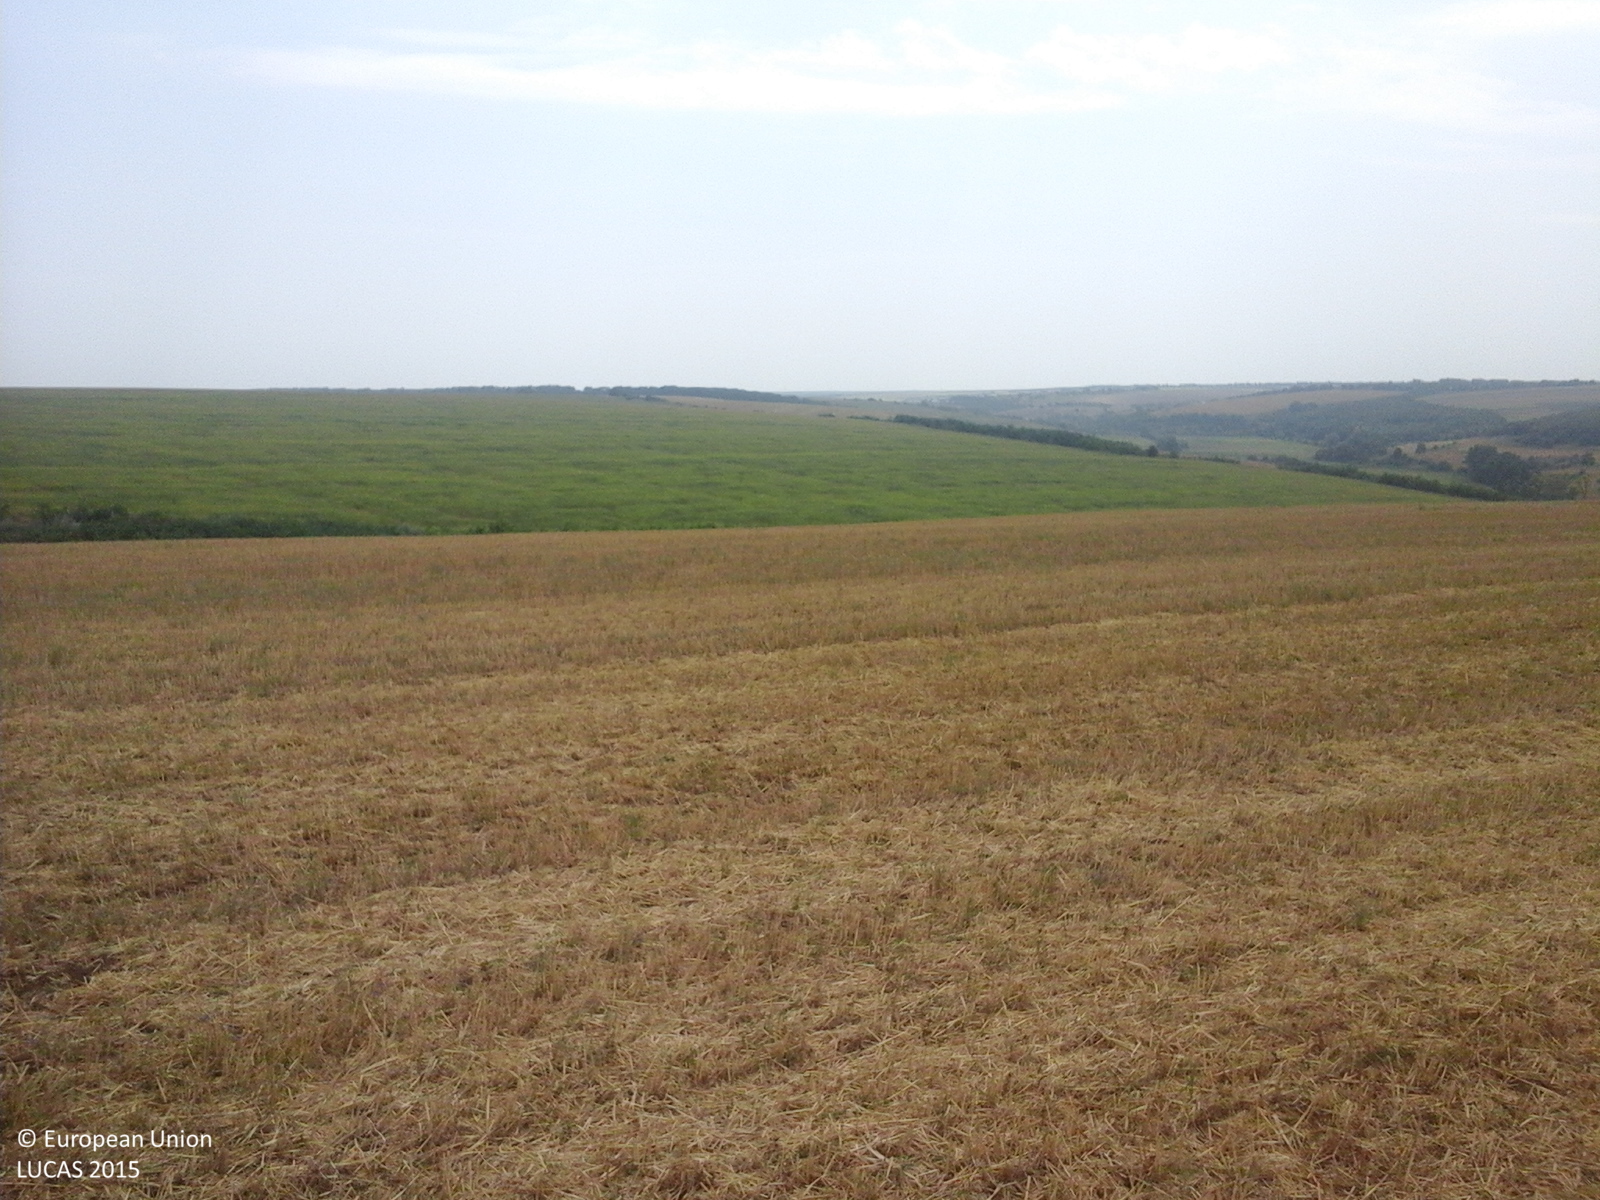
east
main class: Cropland
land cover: Common wheat
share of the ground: 25 - 50 %
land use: Agriculture (excluding fallow land and kitchen gardens)
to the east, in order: Common wheat; Shrubland with sparse tree cover
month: August
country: RO
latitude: 43.9656
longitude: 27.7553
